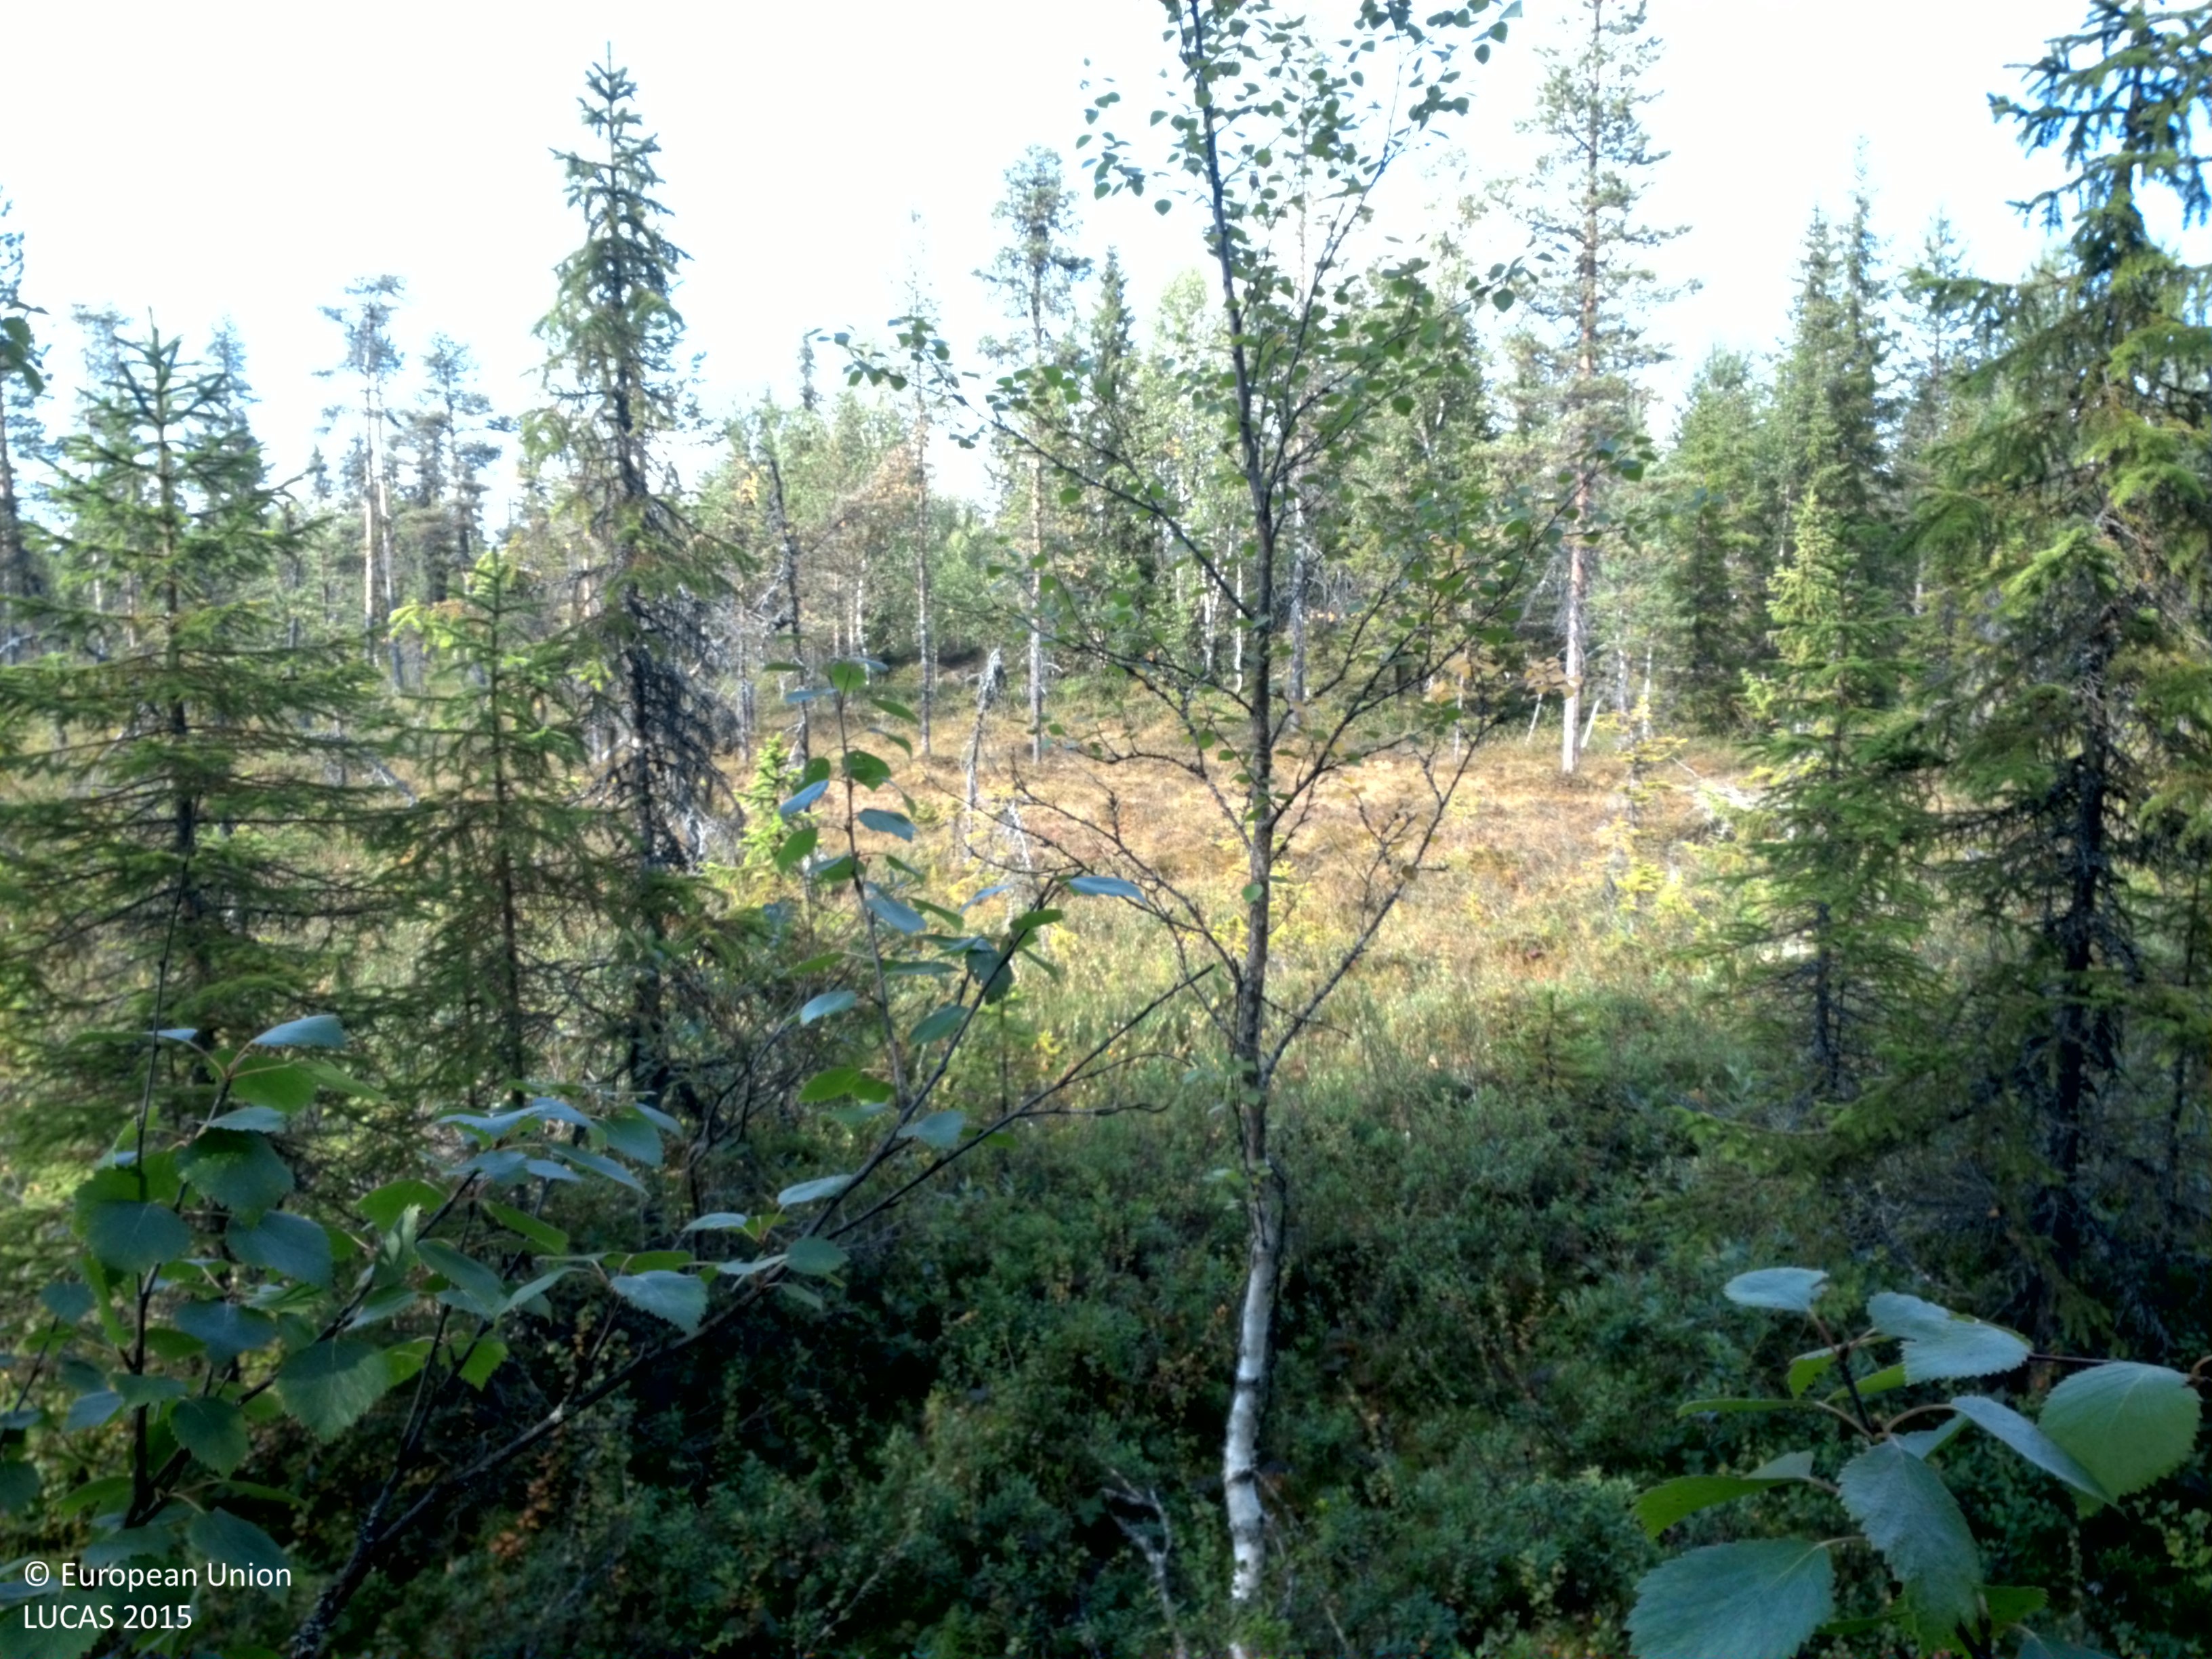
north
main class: Woodland
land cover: Pine dominated mixed woodland
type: boreal forest
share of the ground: 25 - 50 %
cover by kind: shrubs 40 %, coniferous forest trees 30 %, broadleaved forest trees 15 %, lichens and mosses 15 %
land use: Forestry
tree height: > 5 m
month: August
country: SE
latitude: 64.7603
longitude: 16.7968
